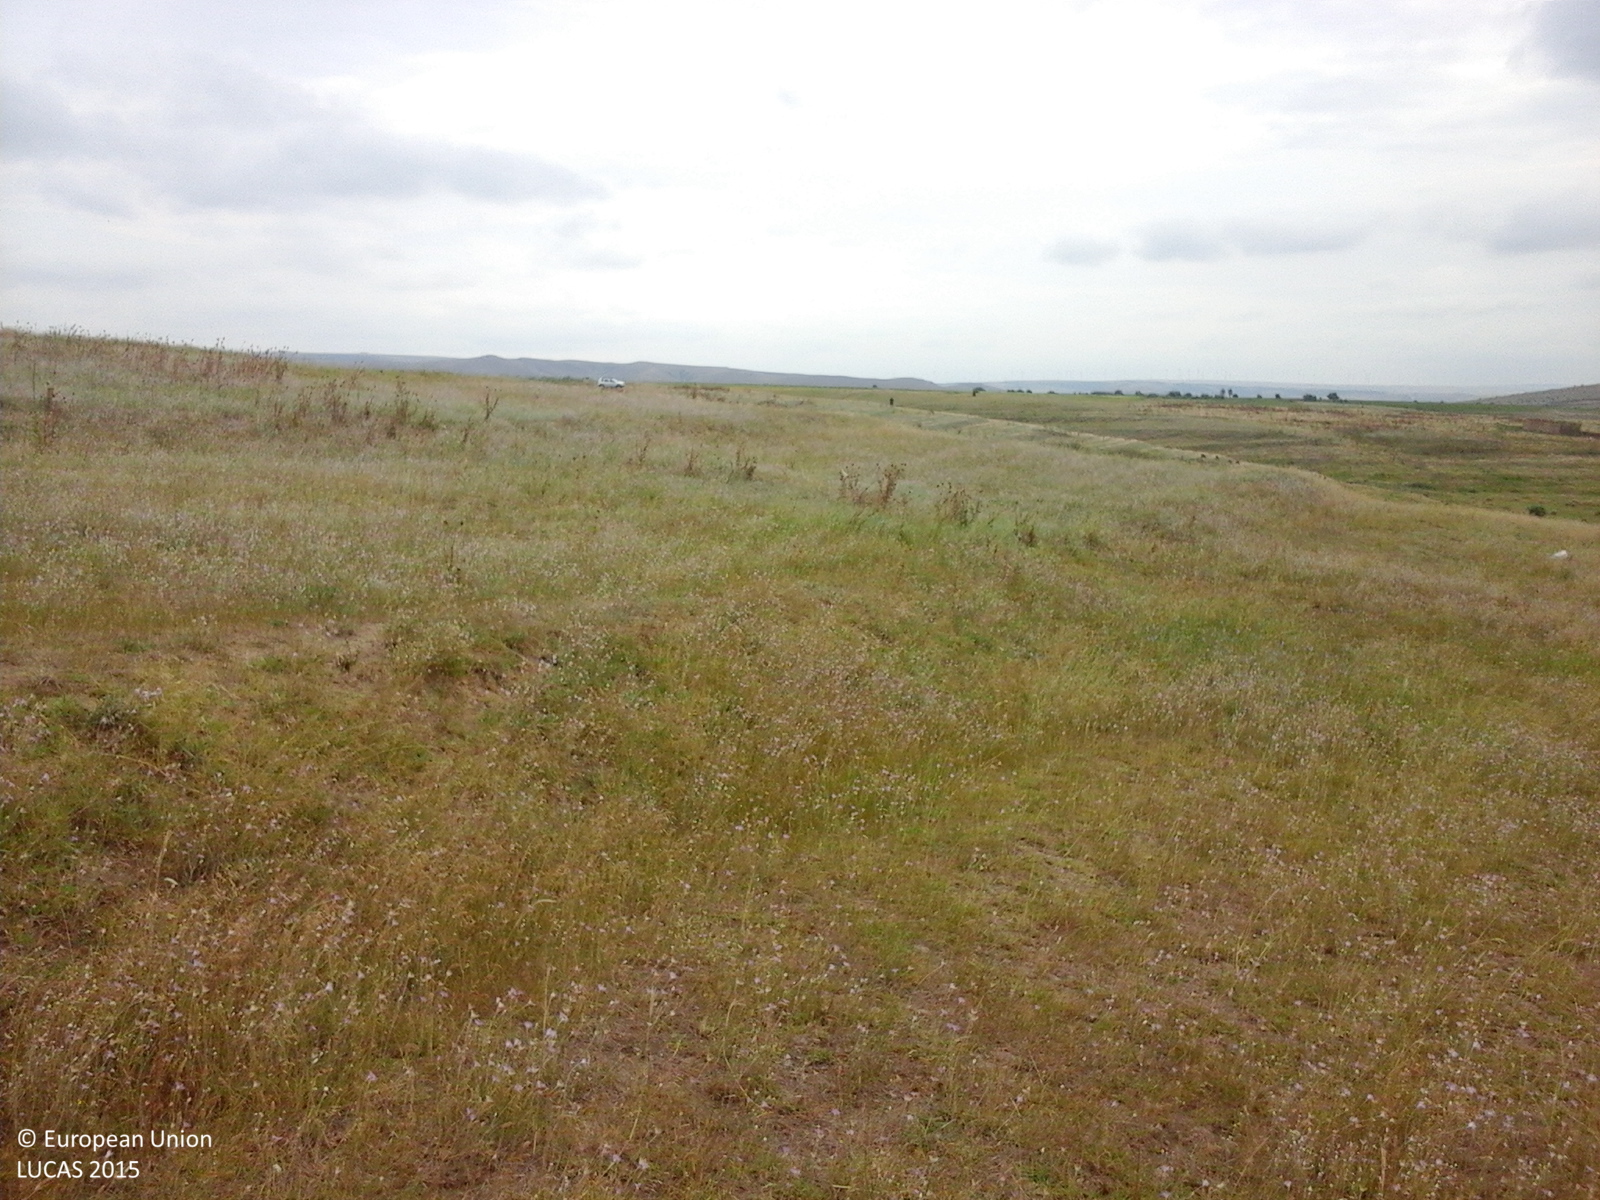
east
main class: Grassland
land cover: Grassland without tree/shrub cover
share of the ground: > 75 %
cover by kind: herbaceous plants 100 %
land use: Agriculture (excluding fallow land and kitchen gardens)
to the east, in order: Grassland without tree/shrub cover
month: August
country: RO
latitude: 44.9078
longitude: 28.1655
